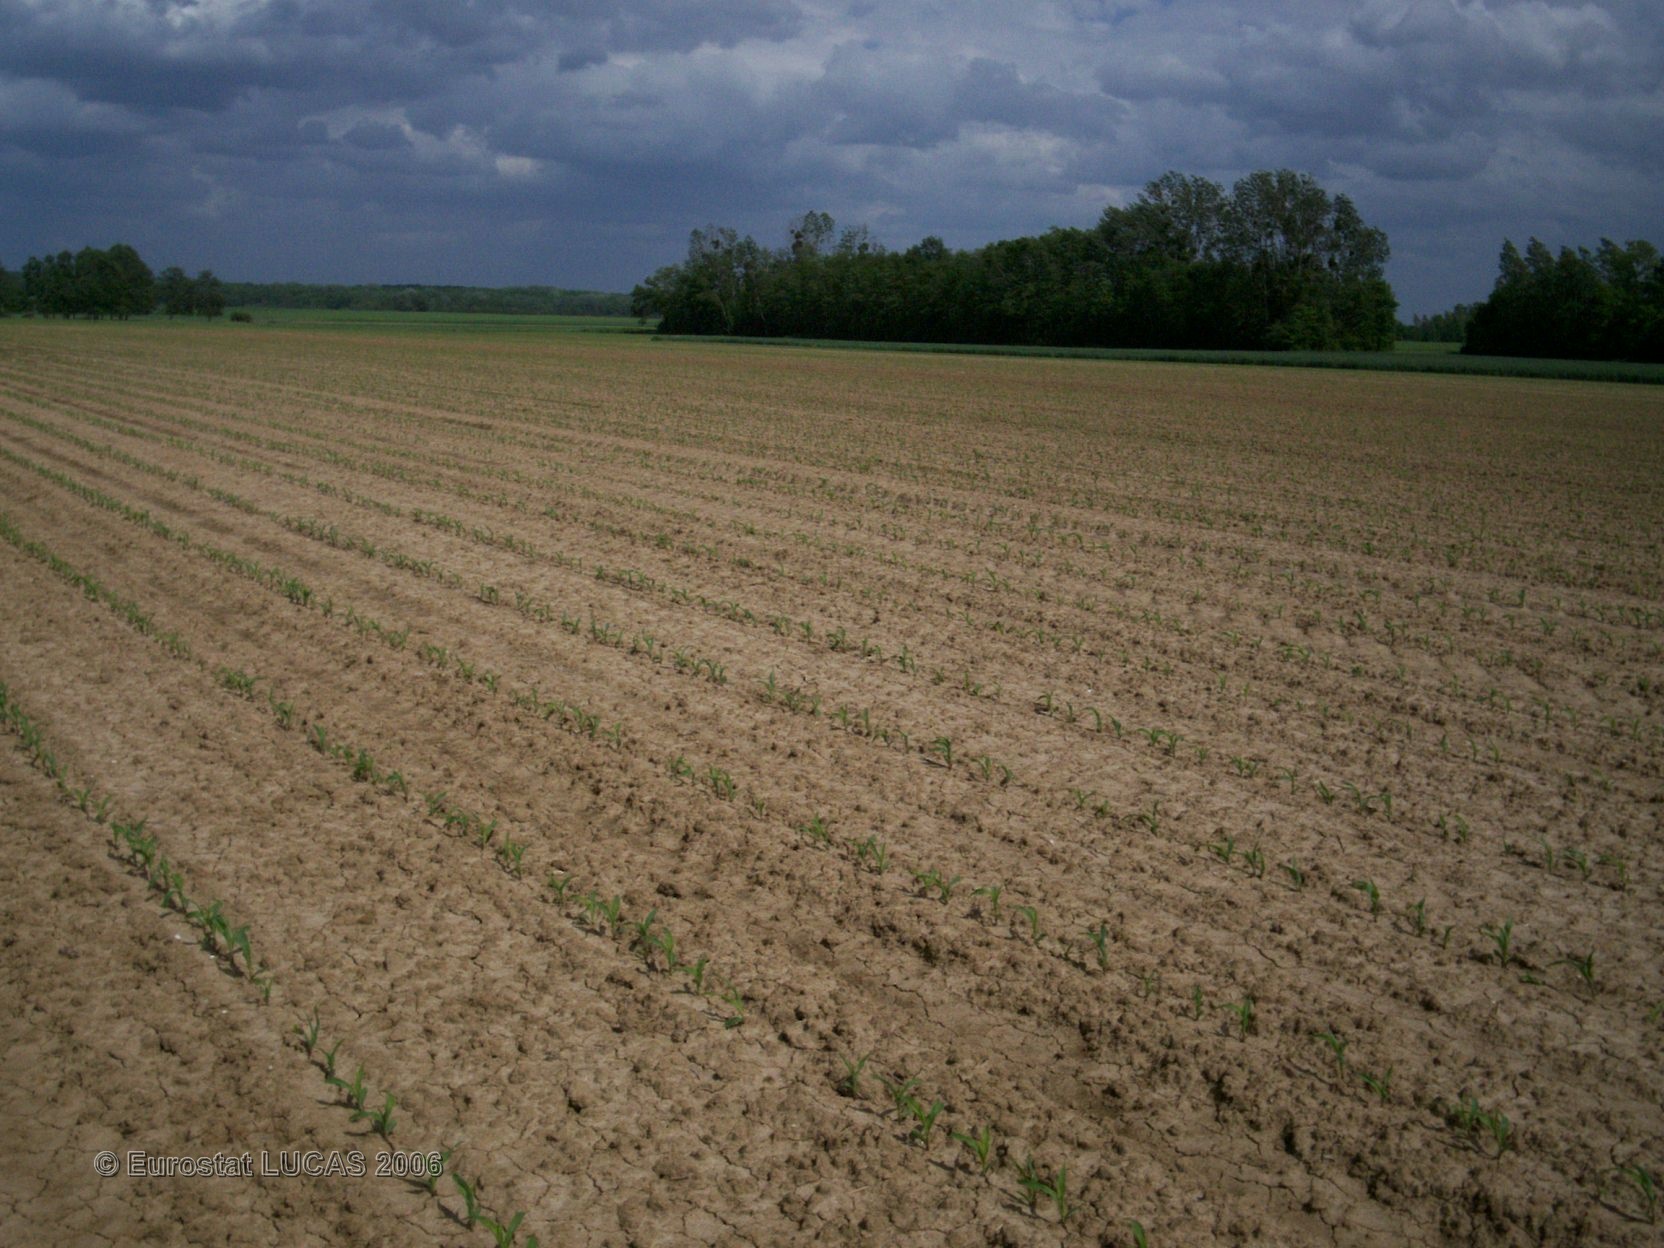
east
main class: Cropland
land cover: Maize
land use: Agriculture (excluding fallow land and kitchen gardens)
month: May
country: FR
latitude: 48.3723
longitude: 4.4489
